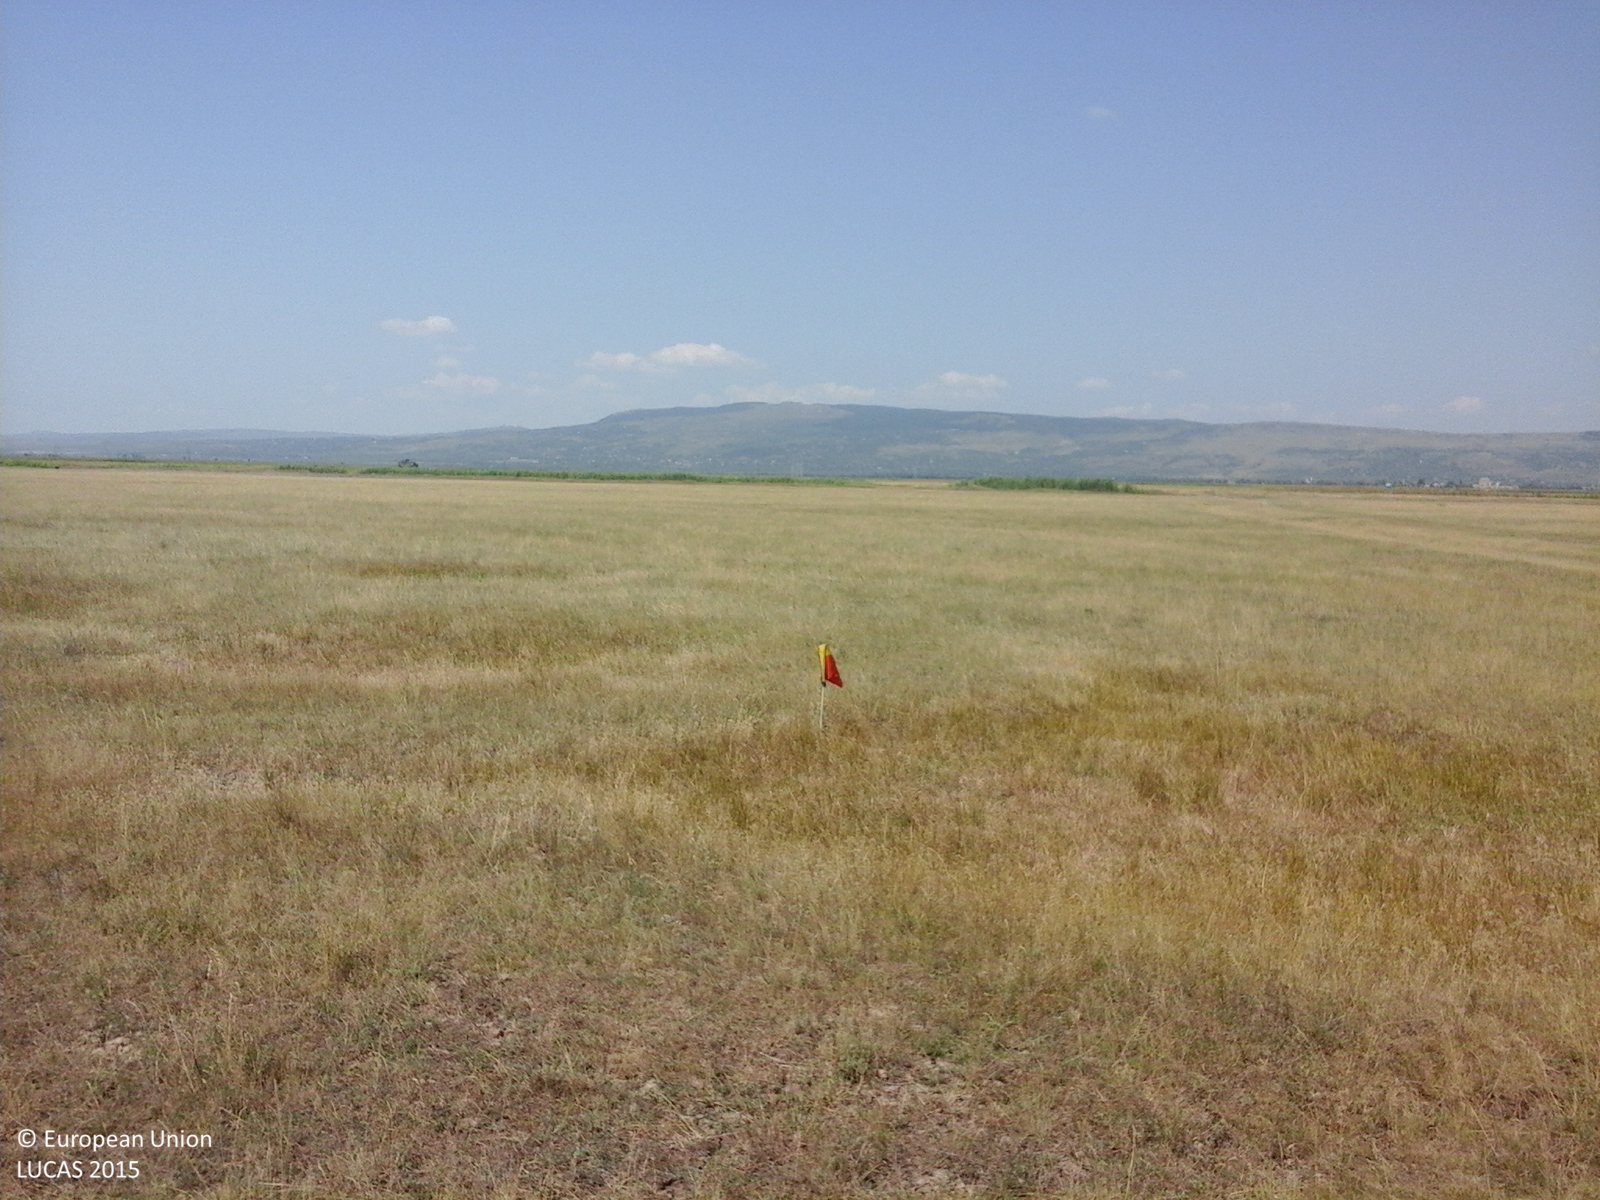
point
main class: Grassland
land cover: Grassland without tree/shrub cover
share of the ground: > 75 %
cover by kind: herbaceous plants 100 %
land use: Agriculture (excluding fallow land and kitchen gardens)
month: July
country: RO
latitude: 45.0496
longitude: 26.6697
